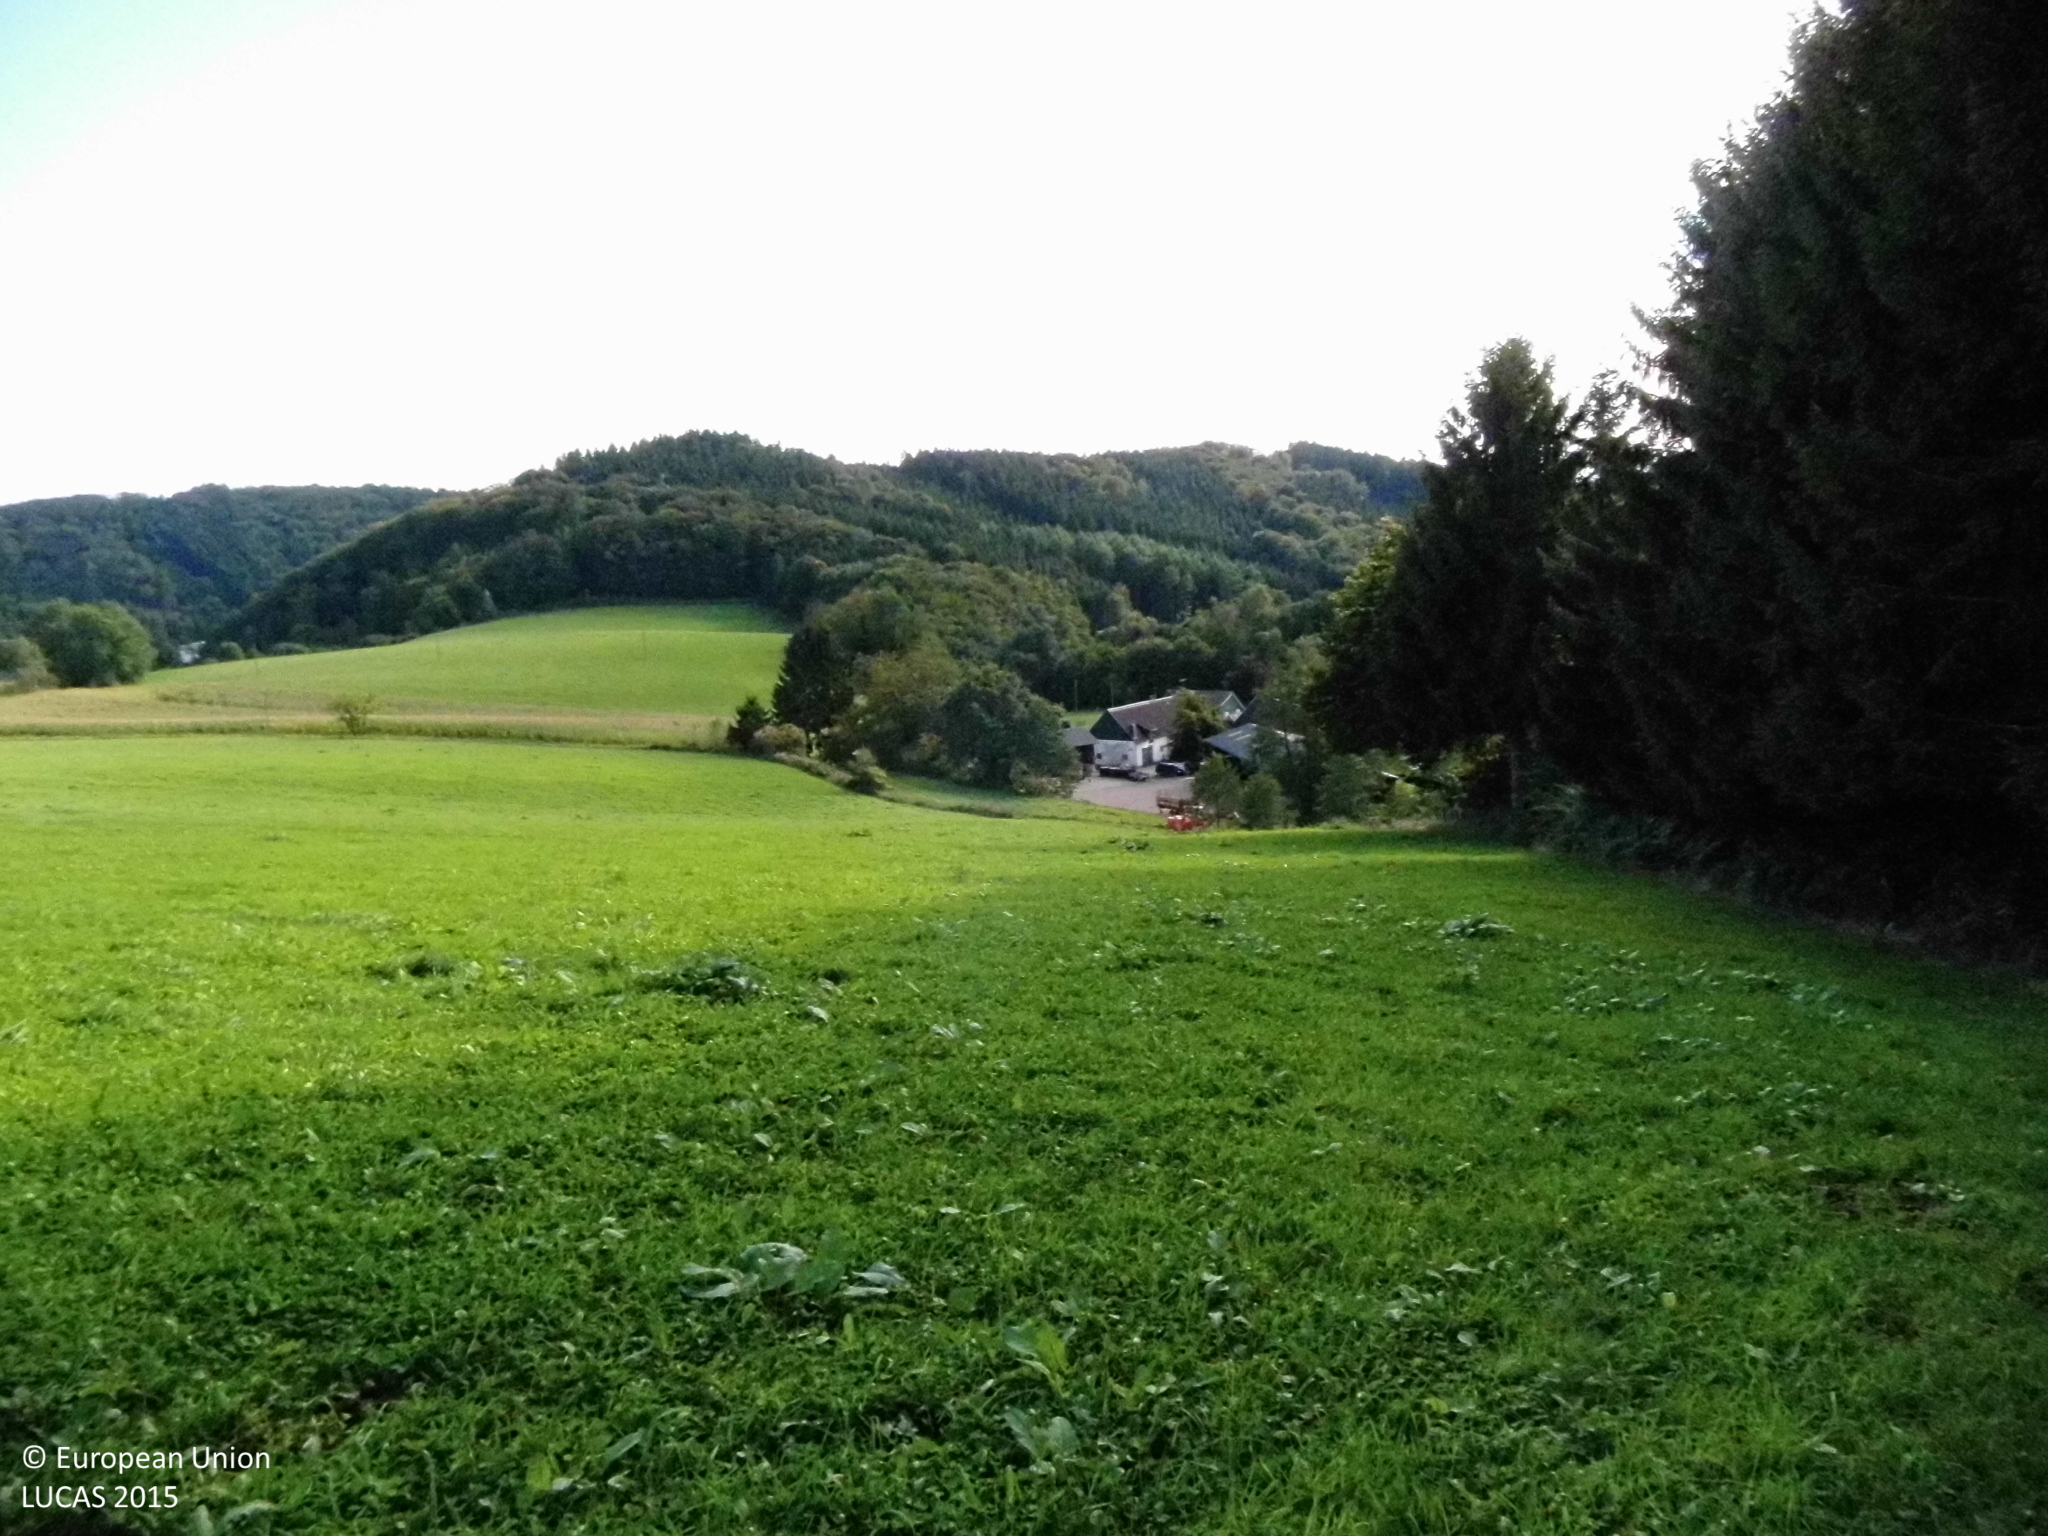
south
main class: Grassland
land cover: Grassland without tree/shrub cover
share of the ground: > 75 %
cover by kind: herbaceous plants 100 %
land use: Agriculture (excluding fallow land and kitchen gardens)
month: September
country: DE
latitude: 51.0725
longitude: 7.4170
